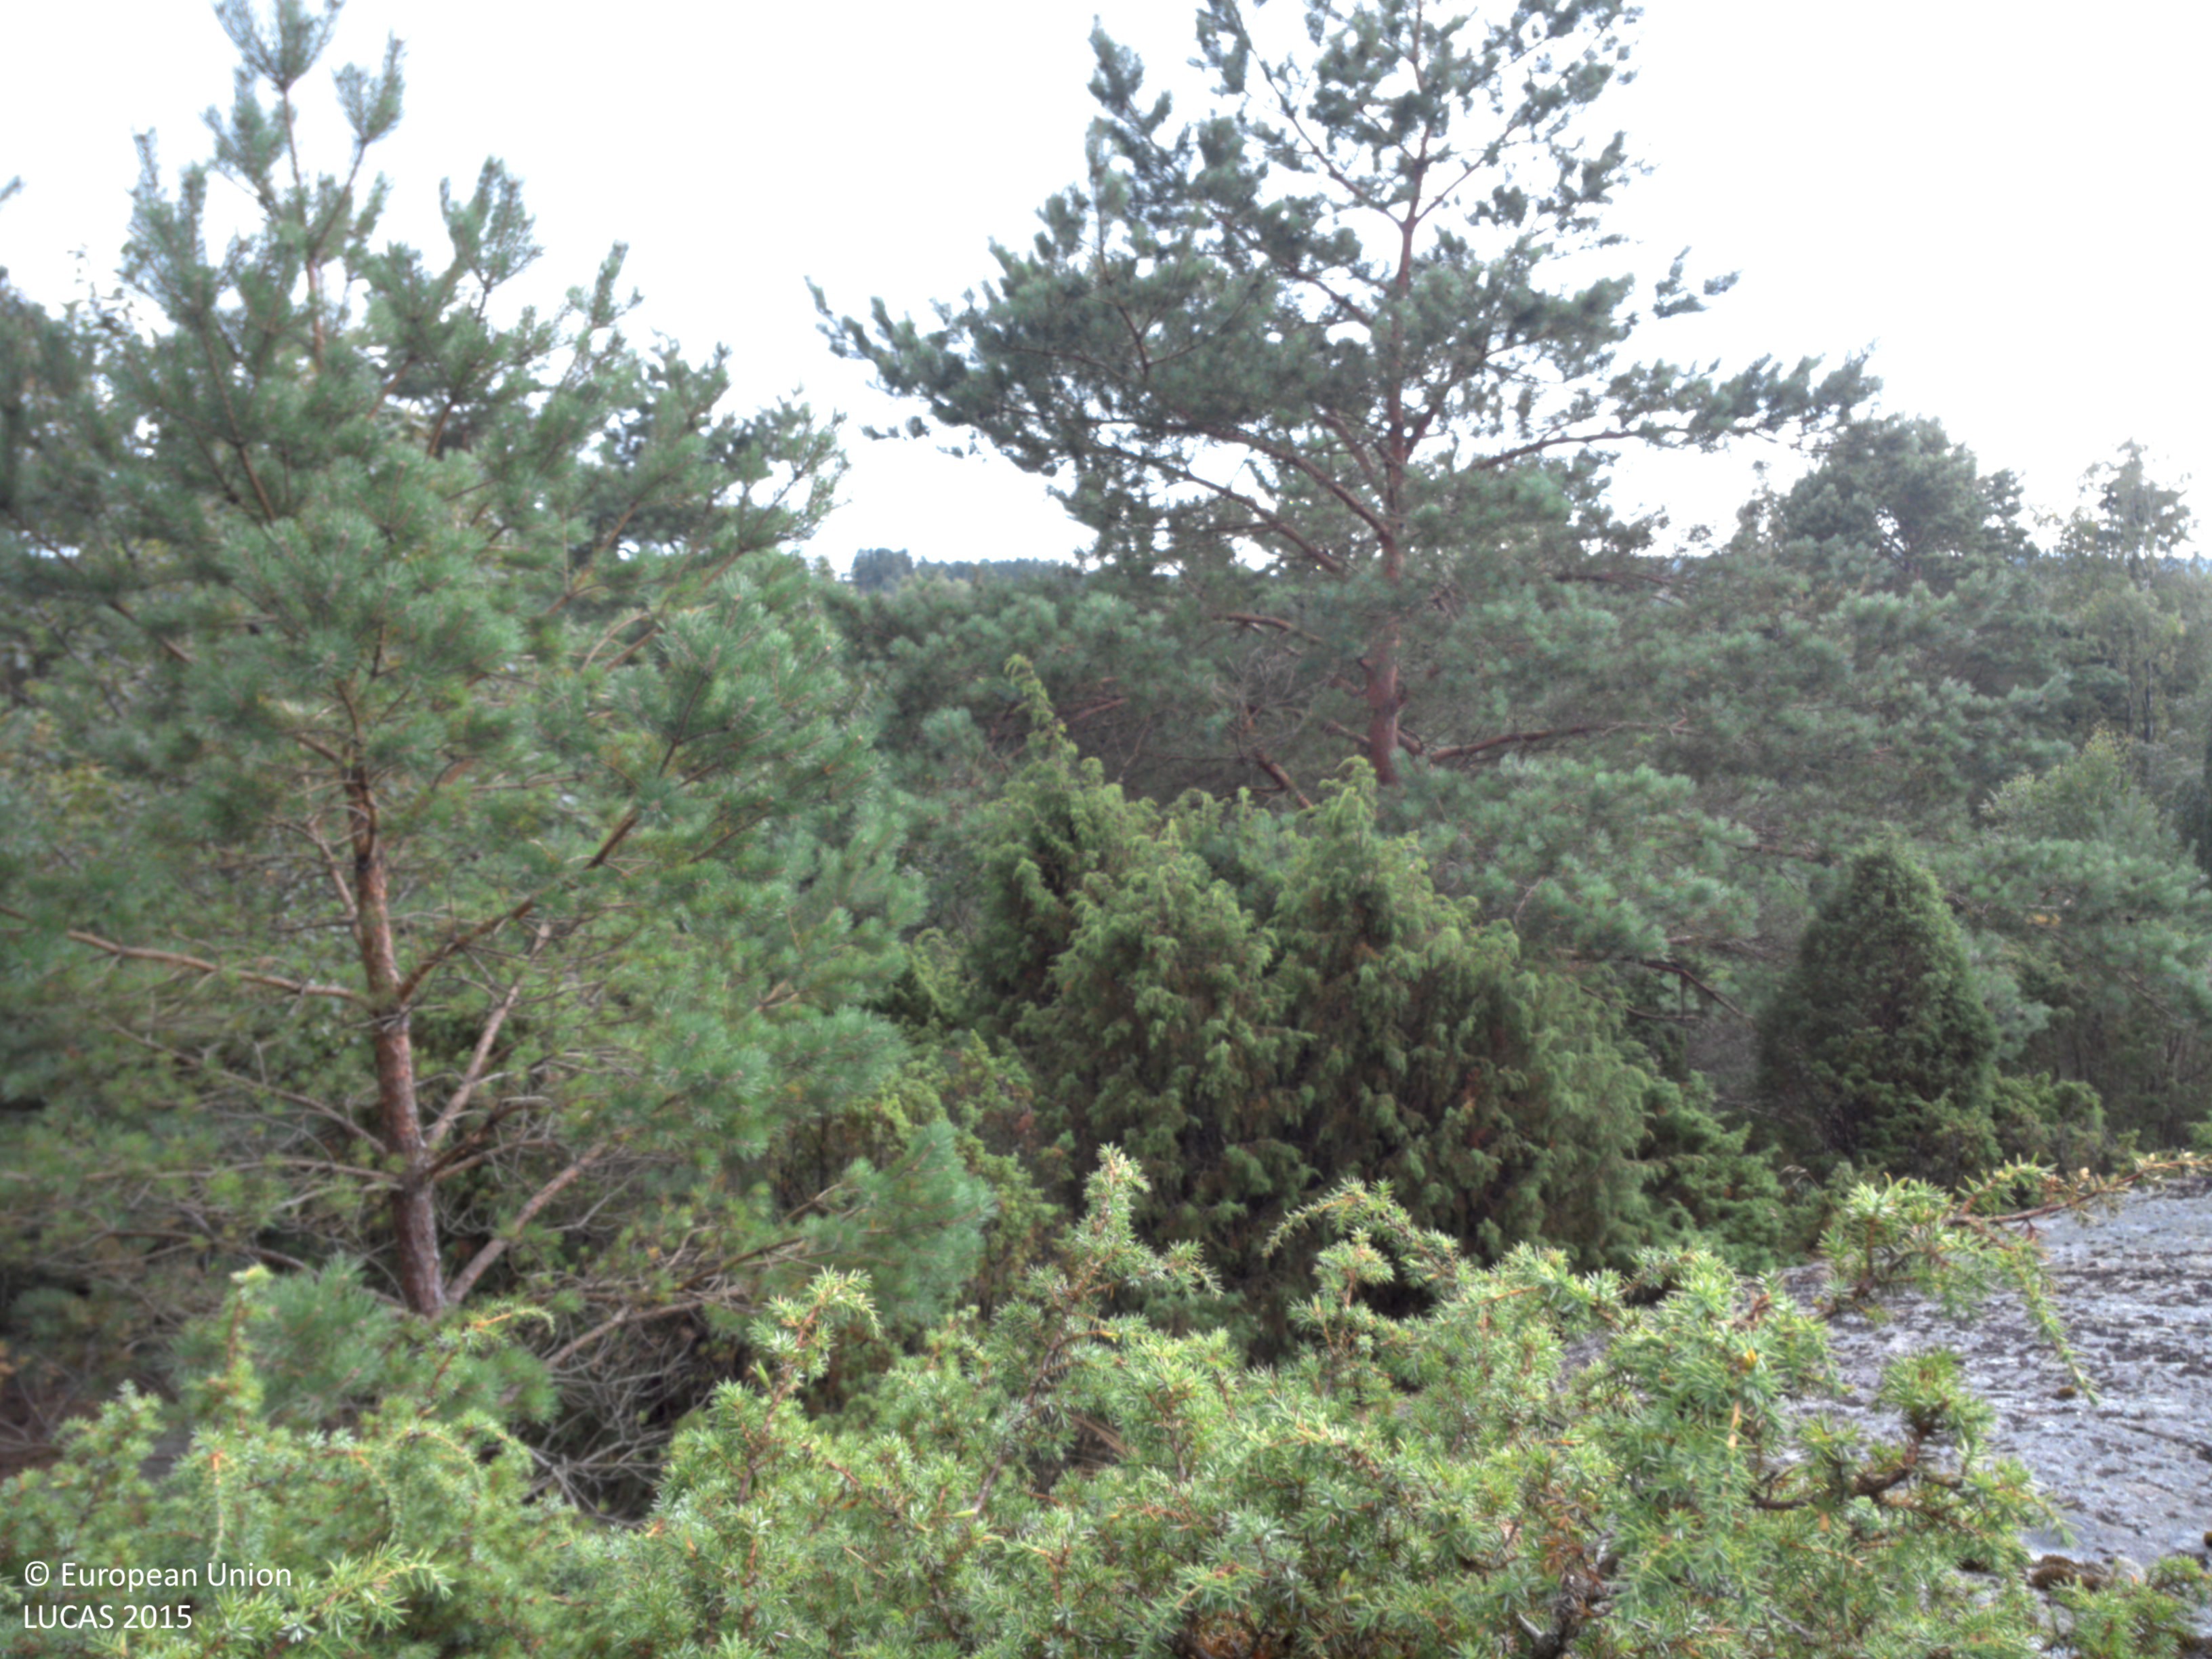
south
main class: Woodland
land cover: Pine dominated coniferous woodland
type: boreal forest
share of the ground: 50 - 75 %
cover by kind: coniferous forest trees 50 %, shrubs 20 %, lichens and mosses 20 %, unconsolidated bare surface 10 %
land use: Forestry
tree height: < 5 m
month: August
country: SE
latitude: 57.9910
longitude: 11.8404
